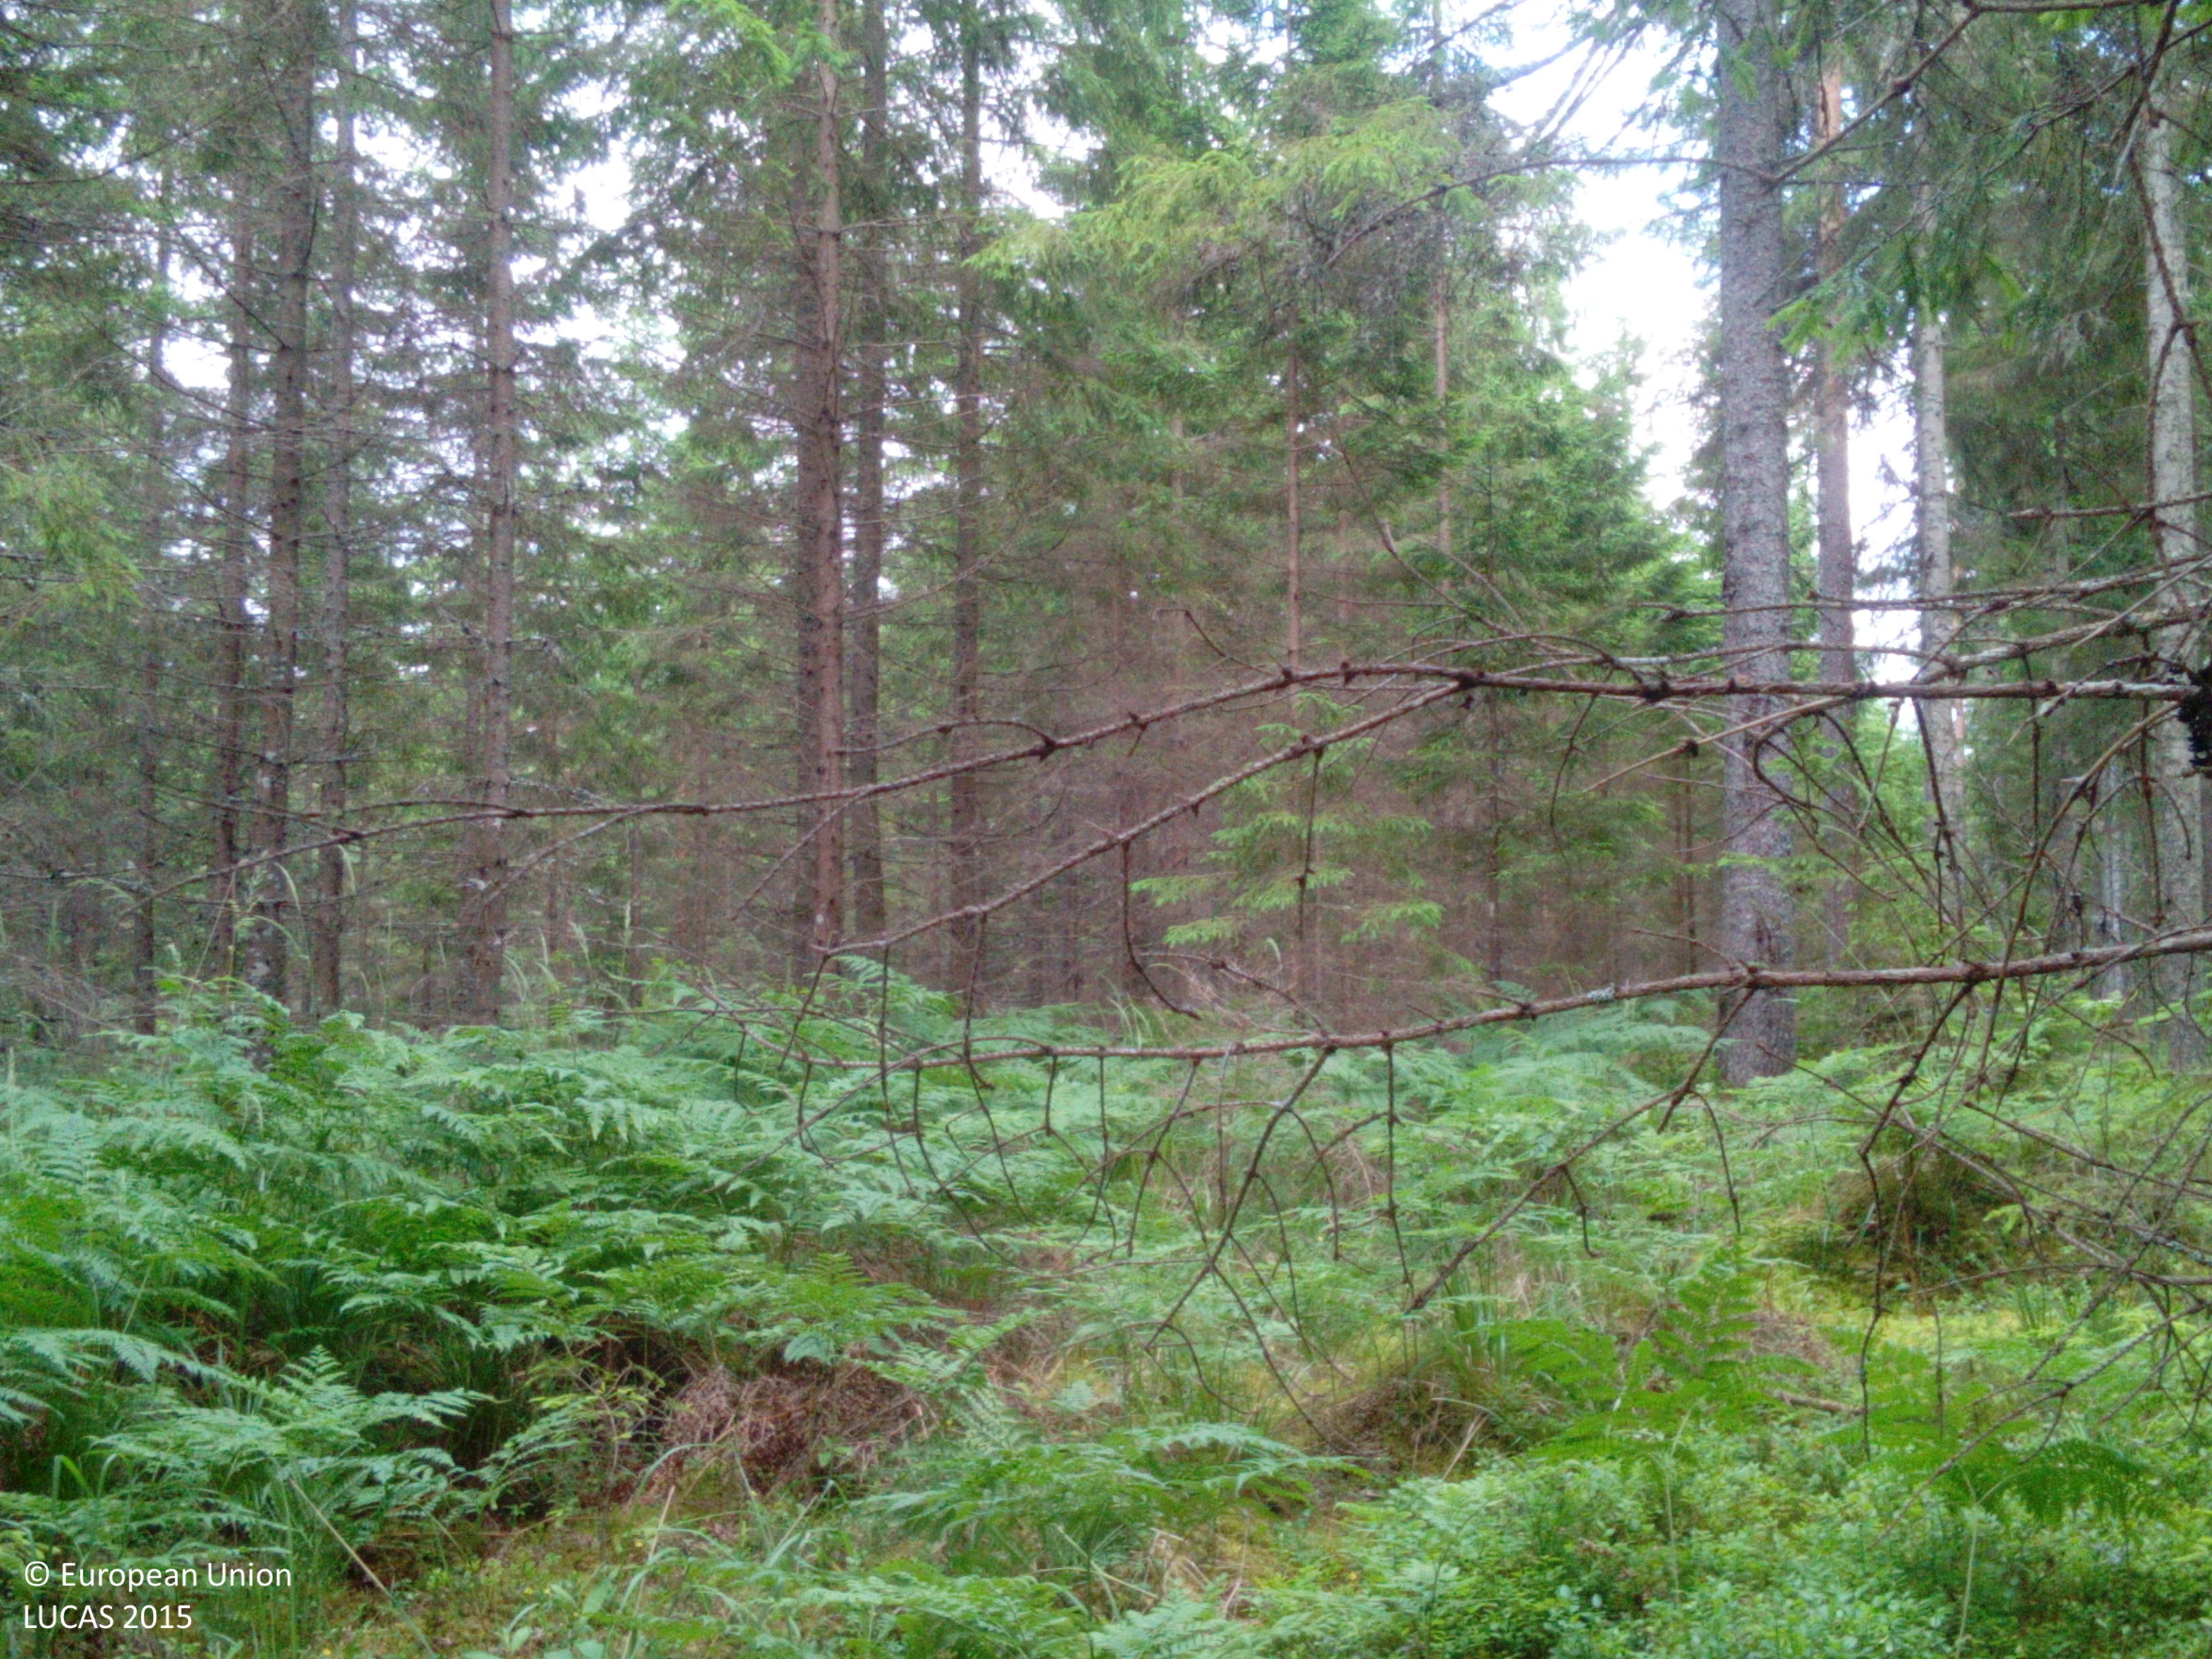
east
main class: Woodland
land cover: Spruce dominated coniferous woodland
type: hemiboreal forest and nemoral coniferous forest and mixed broadleaved-coniferous forest
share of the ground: > 75 %
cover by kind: coniferous forest trees 80 %, herbaceous plants 10 %, broadleaved forest trees 5 %, lichens and mosses 5 %
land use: Forestry
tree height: > 5 m
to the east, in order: Spruce dominated coniferous woodland
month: July
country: LV
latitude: 57.0121
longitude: 22.3209
